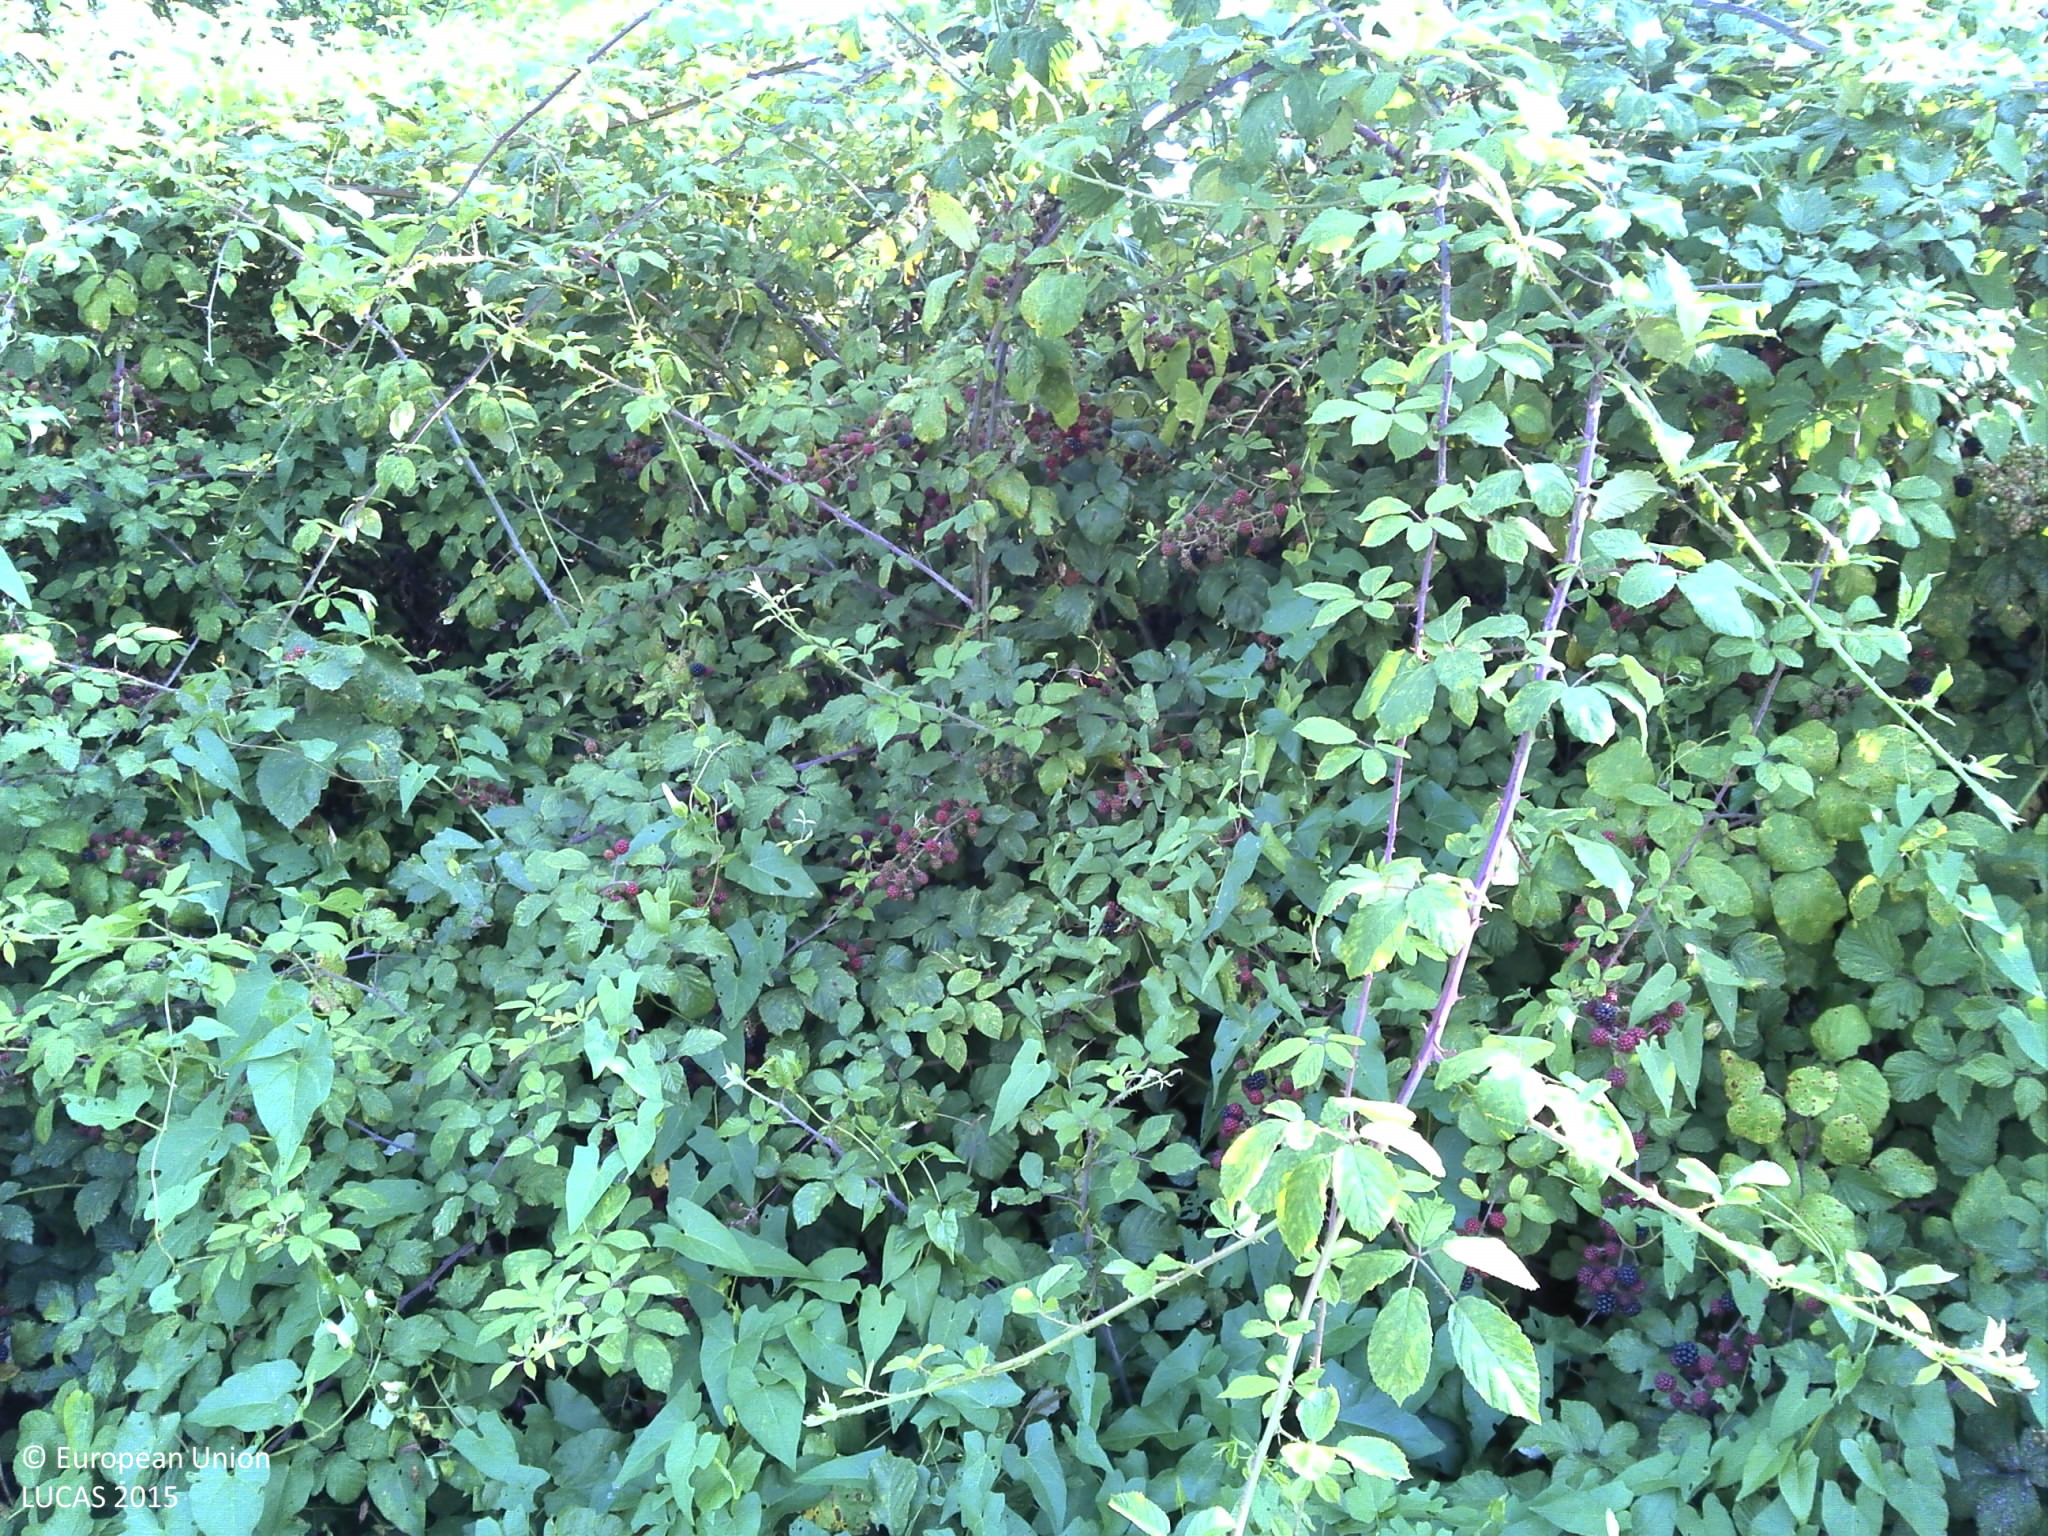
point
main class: Shrubland
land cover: Shrubland with sparse tree cover
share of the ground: > 75 %
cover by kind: shrubs 90 %, broadleaved forest trees 5 %, herbaceous plants 5 %
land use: Semi-natural and natural areas not in use
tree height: > 5 m
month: August
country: FR
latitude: 45.2588
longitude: -0.6110
